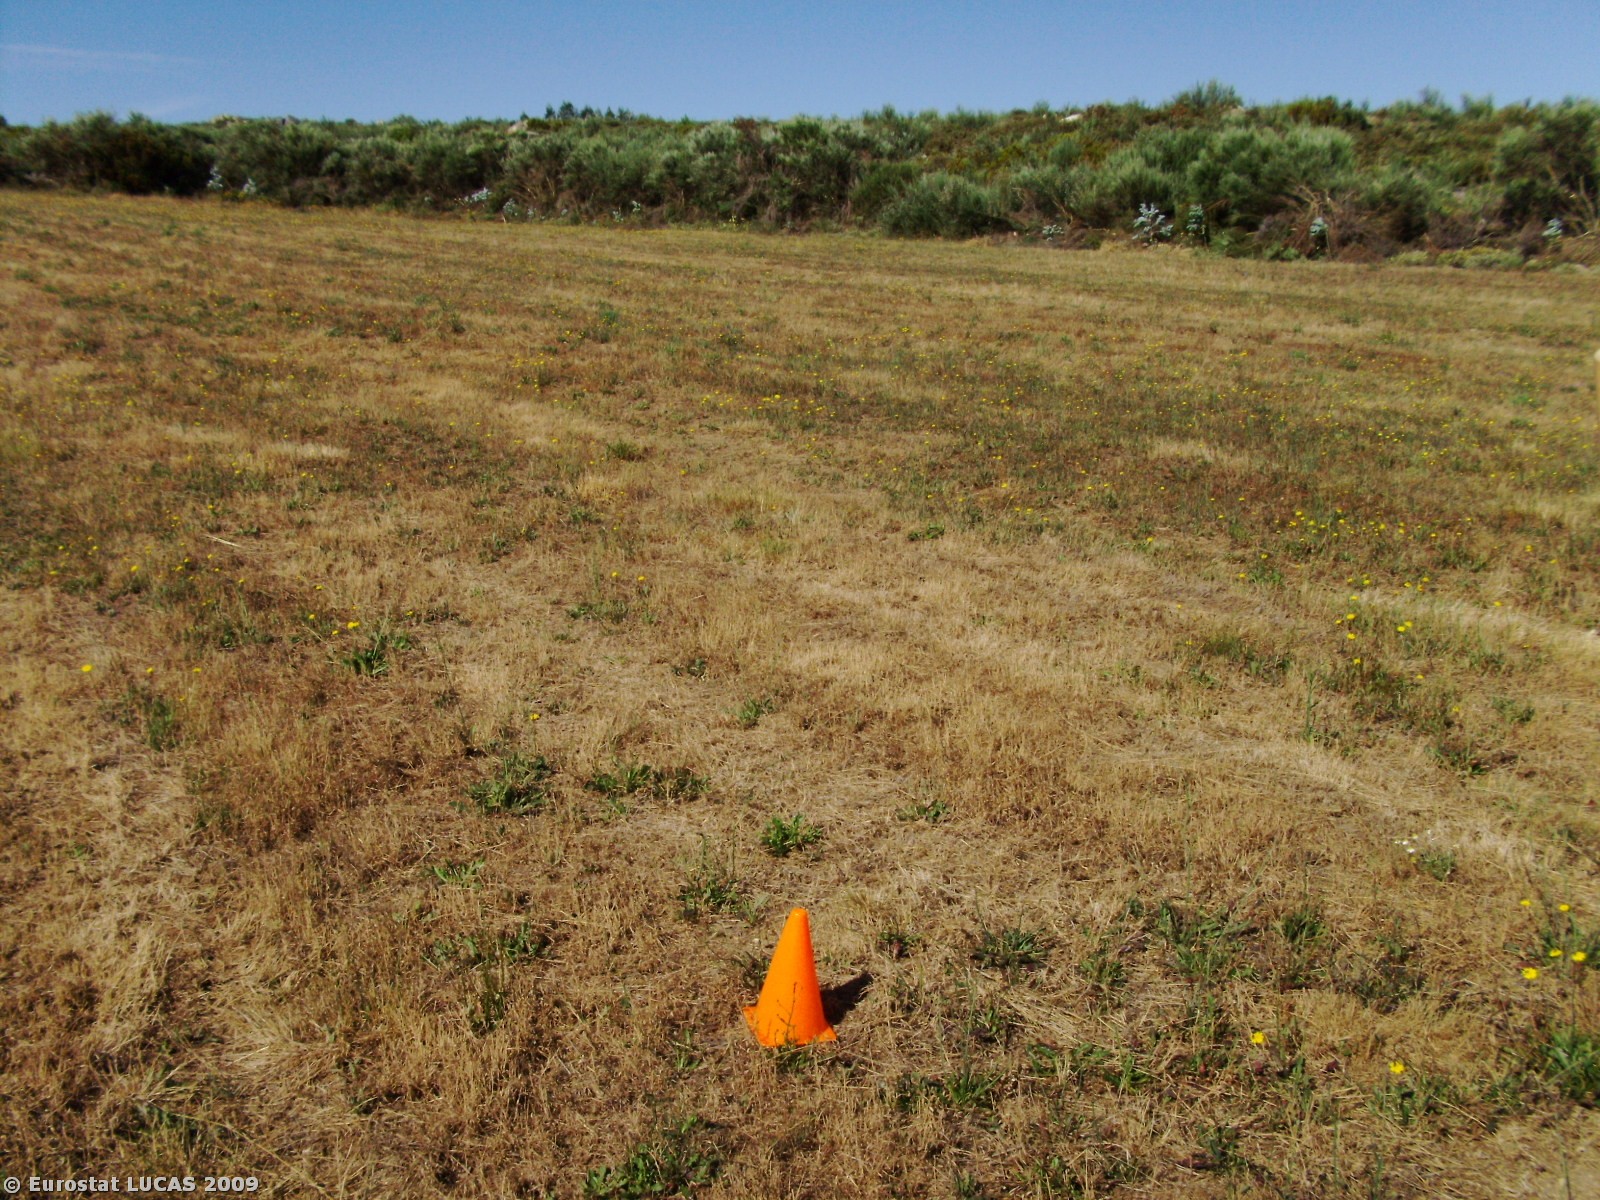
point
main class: Grassland
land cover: Spontaneously vegetated surfaces
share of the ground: > 75 %
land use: Fallow land
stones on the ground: < 10 %
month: July
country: PT
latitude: 40.9657
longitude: -7.7222
